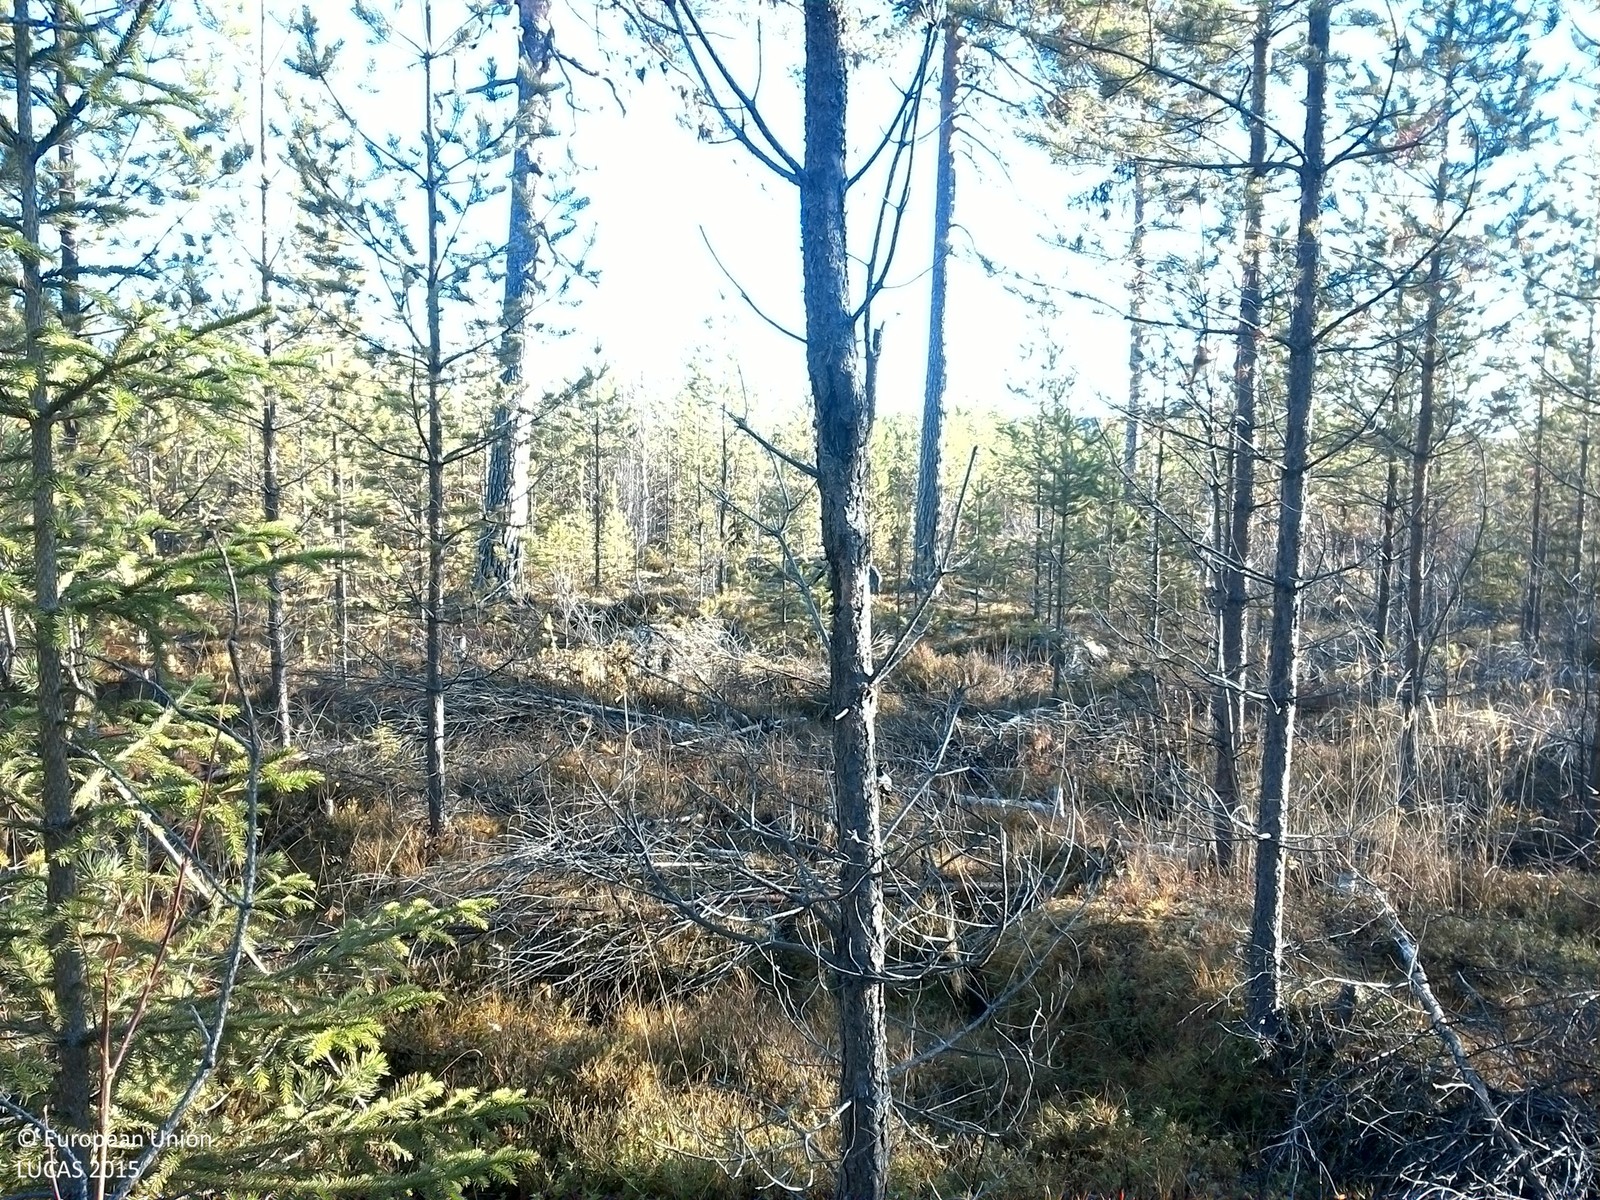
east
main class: Woodland
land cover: Pine dominated coniferous woodland
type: boreal forest
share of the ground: 25 - 50 %
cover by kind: shrubs 40 %, coniferous forest trees 35 %, lichens and mosses 20 %, broadleaved forest trees 5 %
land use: Forestry
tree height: < 5 m
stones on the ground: > 50 %
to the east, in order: Pine dominated coniferous woodland; Paved roads, cycling and walking lanes; Broadleaved woodland; Rivers and streams; Broadleaved woodland; Other mixed woodland; Rivers and streams; Pine dominated mixed woodland
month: October
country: SE
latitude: 63.7433
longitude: 15.9498
